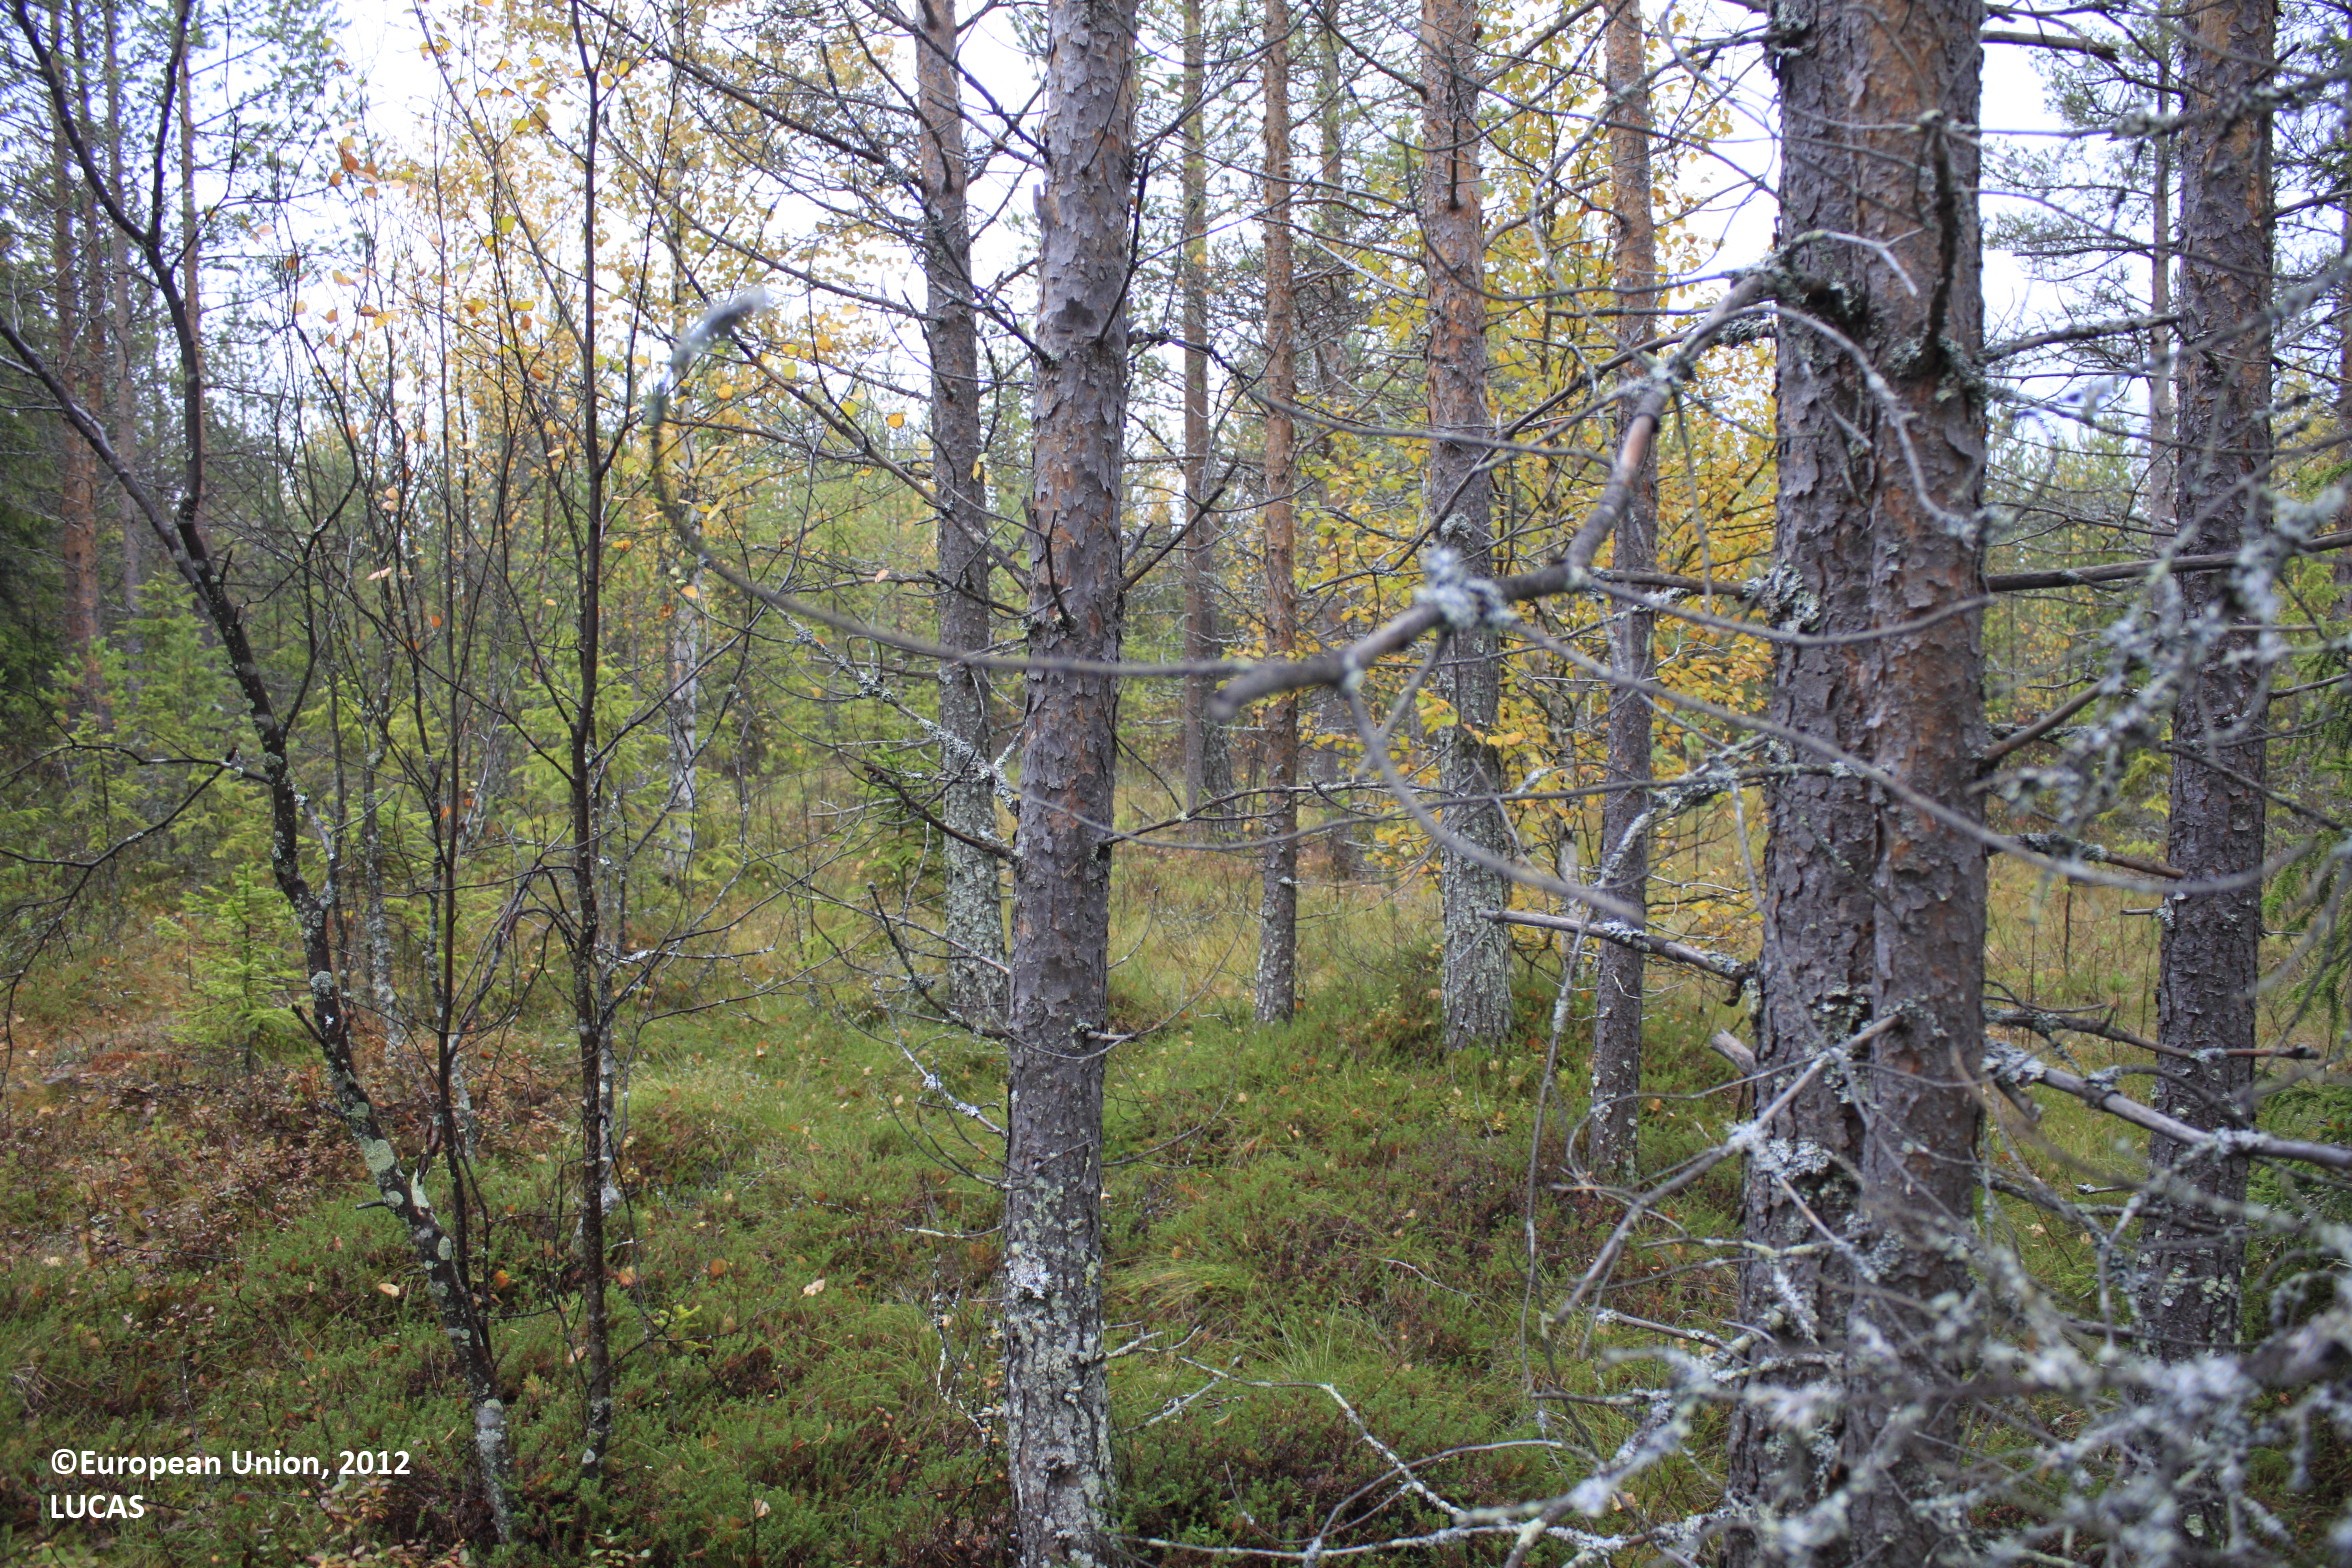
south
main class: Woodland
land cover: Pine dominated coniferous woodland
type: boreal forest
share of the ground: 25 - 50 %
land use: Forestry
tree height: > 5 m
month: September
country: FI
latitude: 65.7325
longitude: 27.2353
